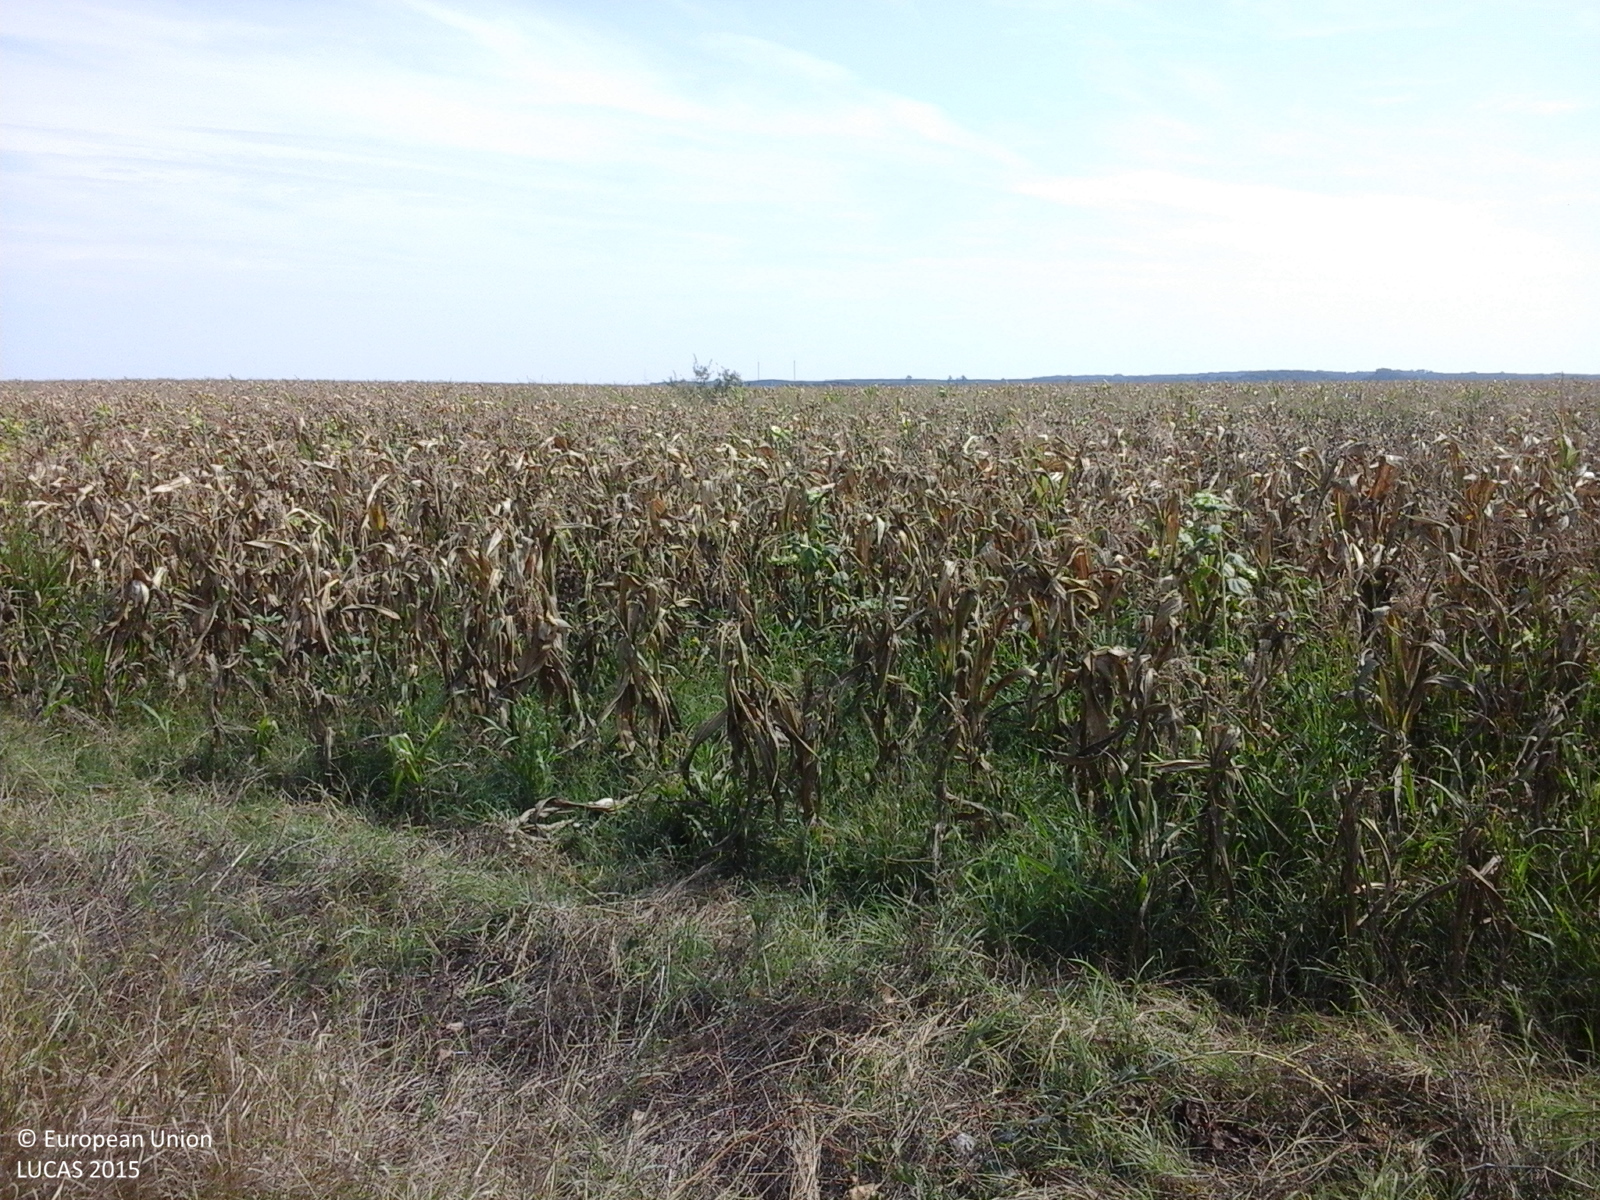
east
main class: Cropland
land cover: Maize
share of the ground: > 75 %
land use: Agriculture (excluding fallow land and kitchen gardens)
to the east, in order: Maize
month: August
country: RO
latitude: 46.1859
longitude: 21.1350
